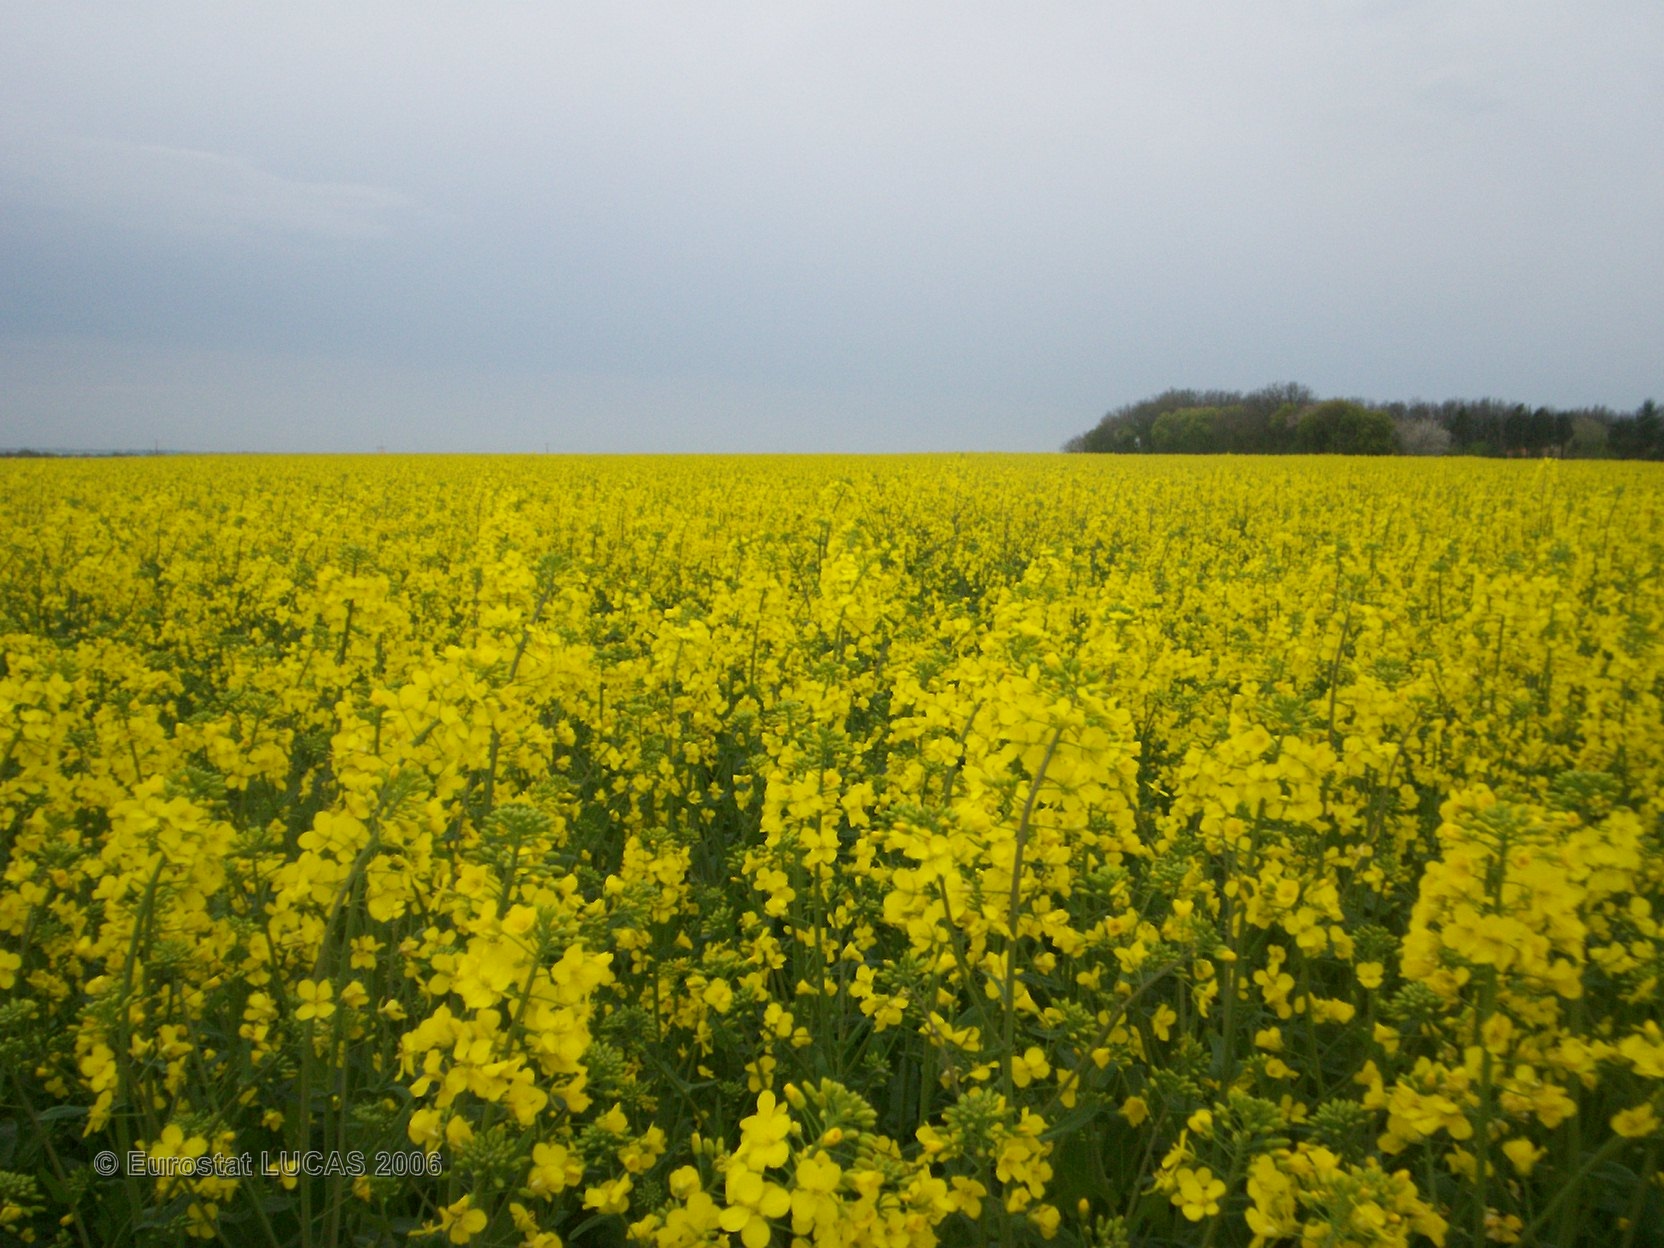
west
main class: Cropland
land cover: Rape and turnip rape
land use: Agriculture (excluding fallow land and kitchen gardens)
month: April
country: FR
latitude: 46.1214
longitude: -0.7029
